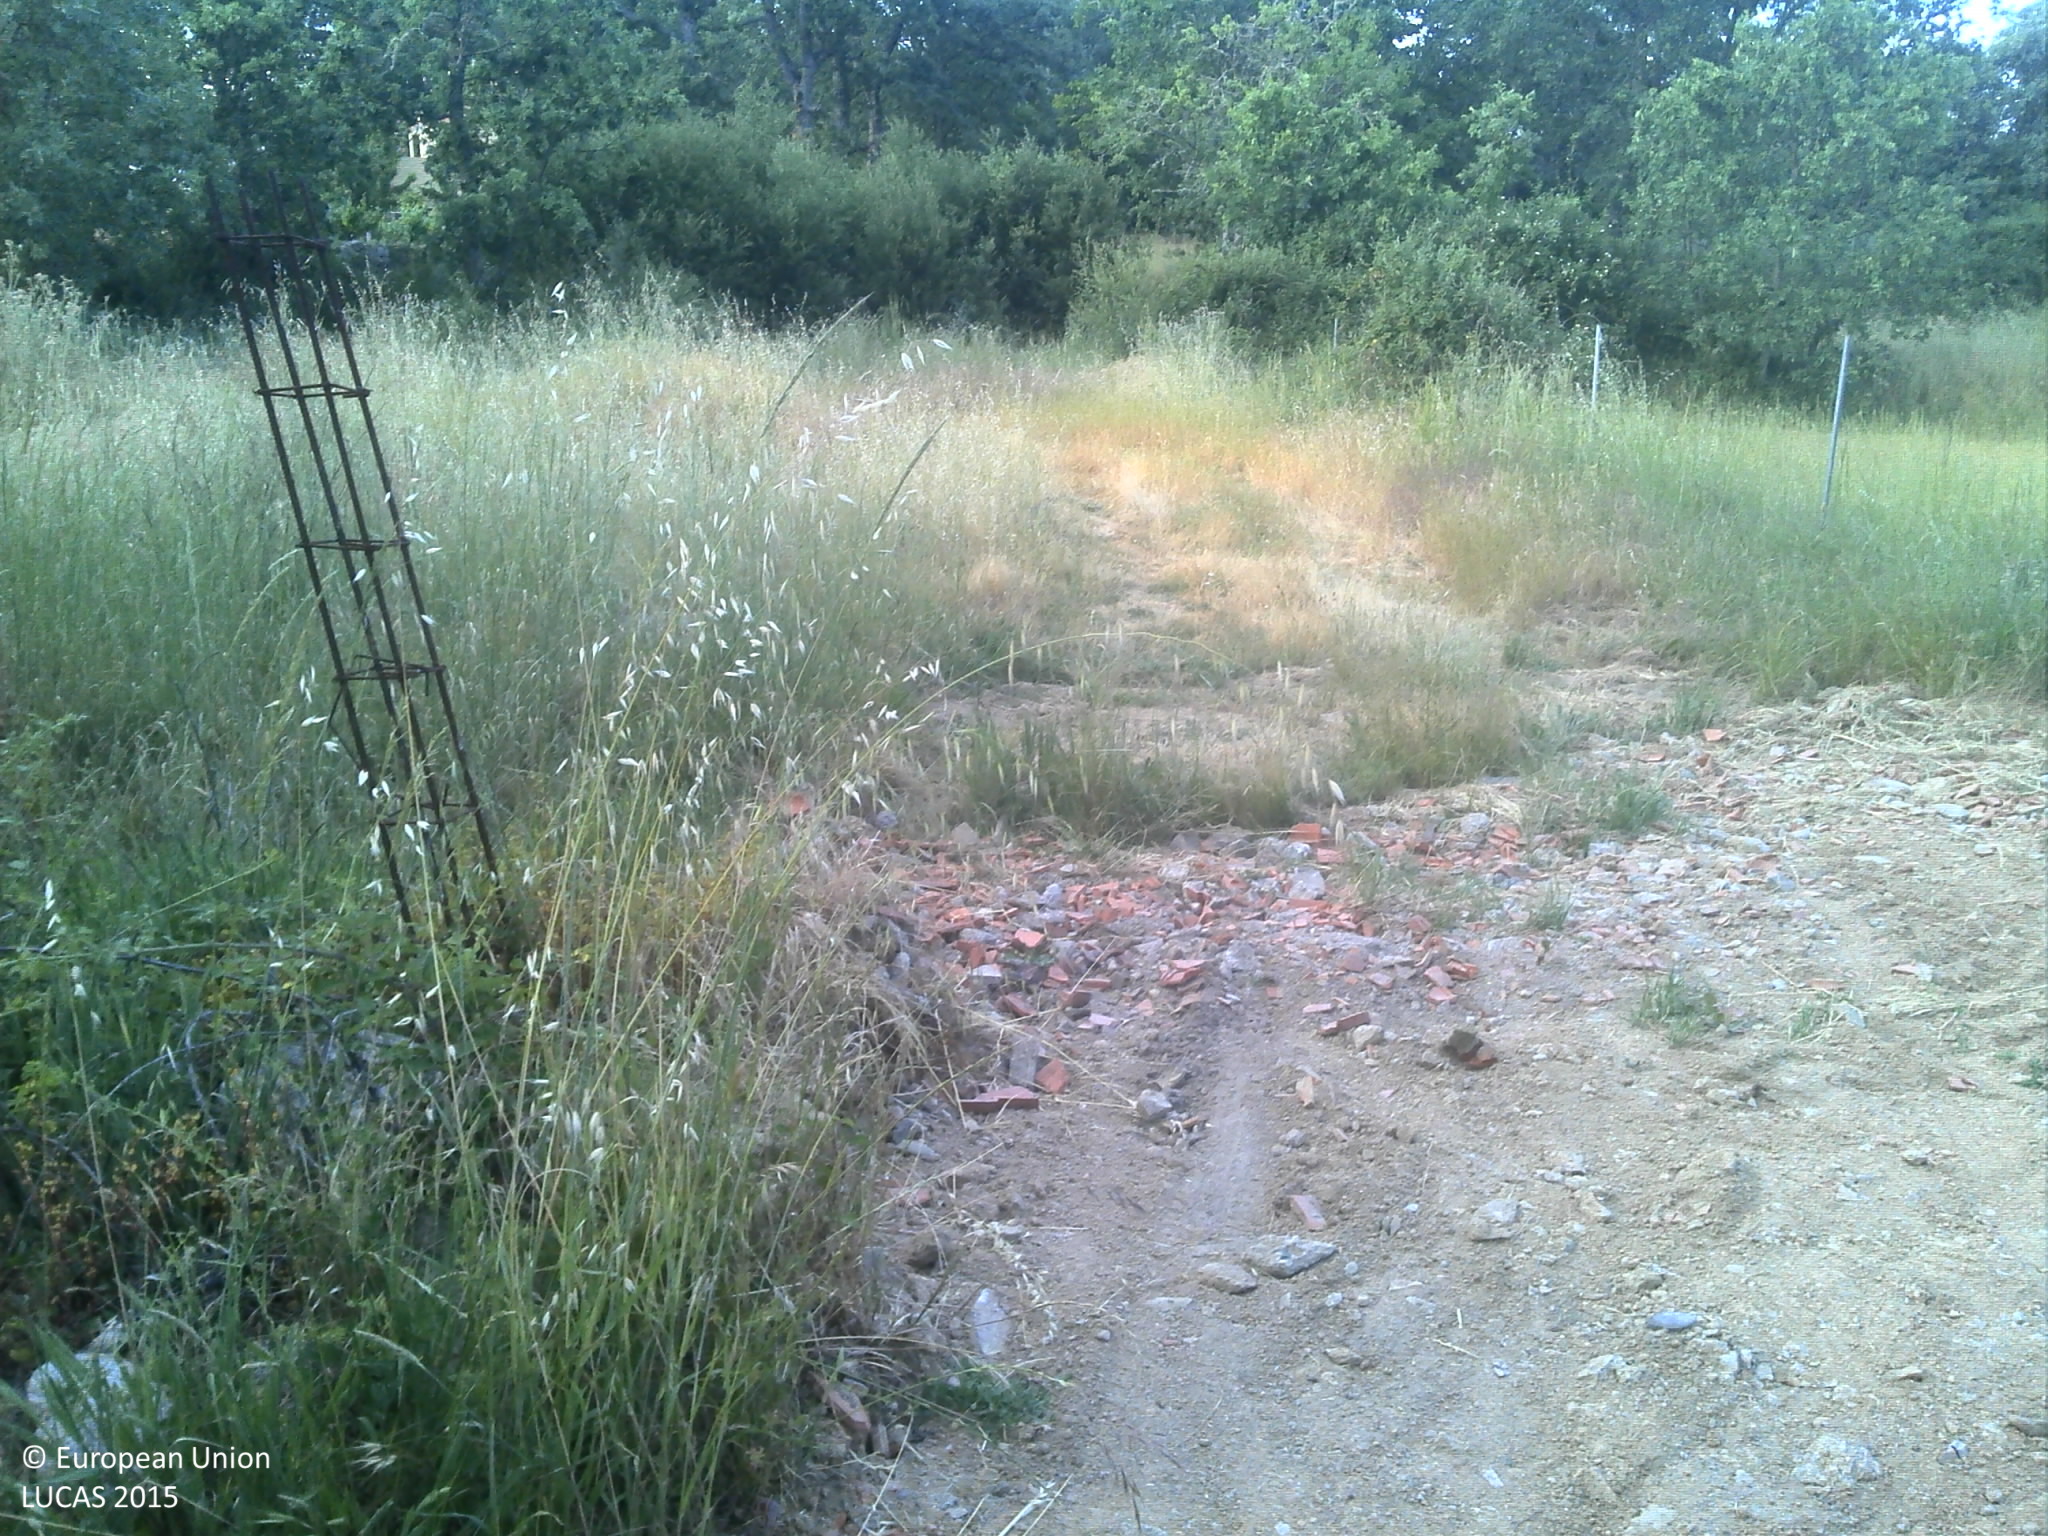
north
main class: Cropland
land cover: Arable land (only in case pi)
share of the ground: 50 - 75 %
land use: Agriculture (excluding fallow land and kitchen gardens)
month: June
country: PT
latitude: 40.4569
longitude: -7.1654
